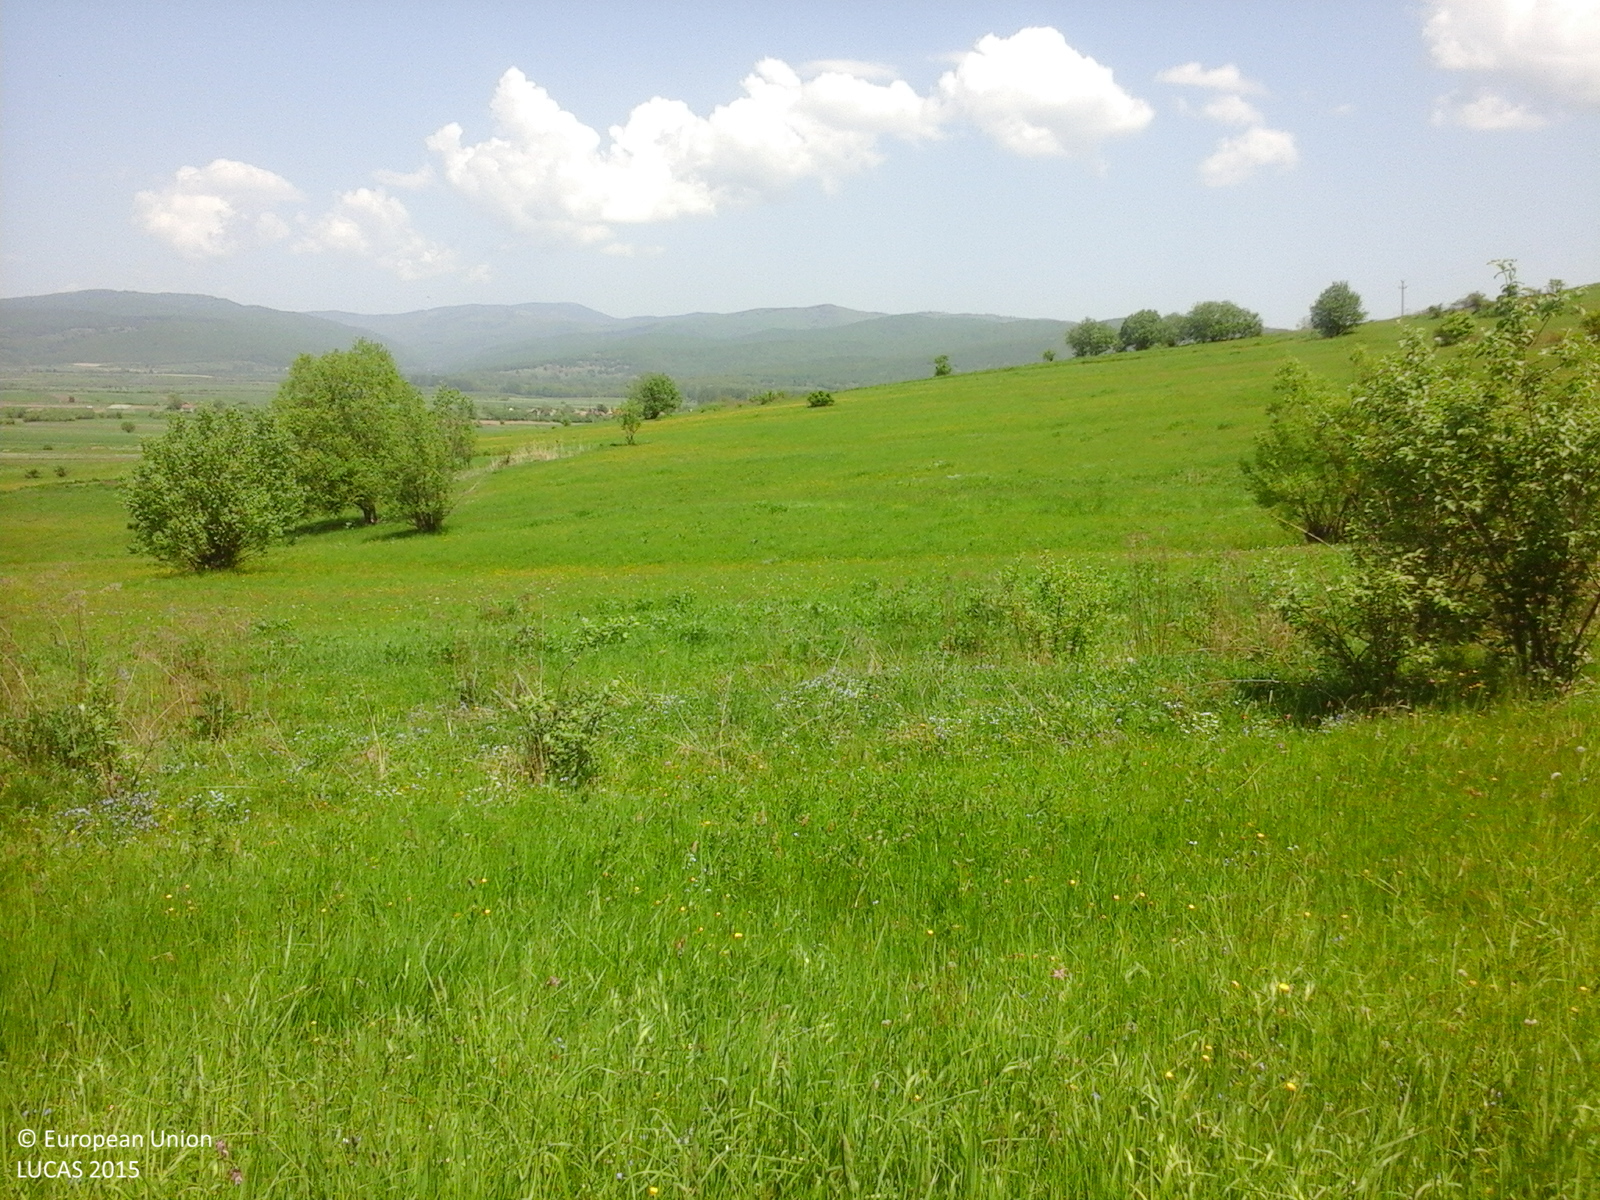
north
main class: Grassland
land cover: Grassland without tree/shrub cover
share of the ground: > 75 %
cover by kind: herbaceous plants 100 %
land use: Agriculture (excluding fallow land and kitchen gardens)
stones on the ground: < 10 %
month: May
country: RO
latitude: 46.0286
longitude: 26.2864
